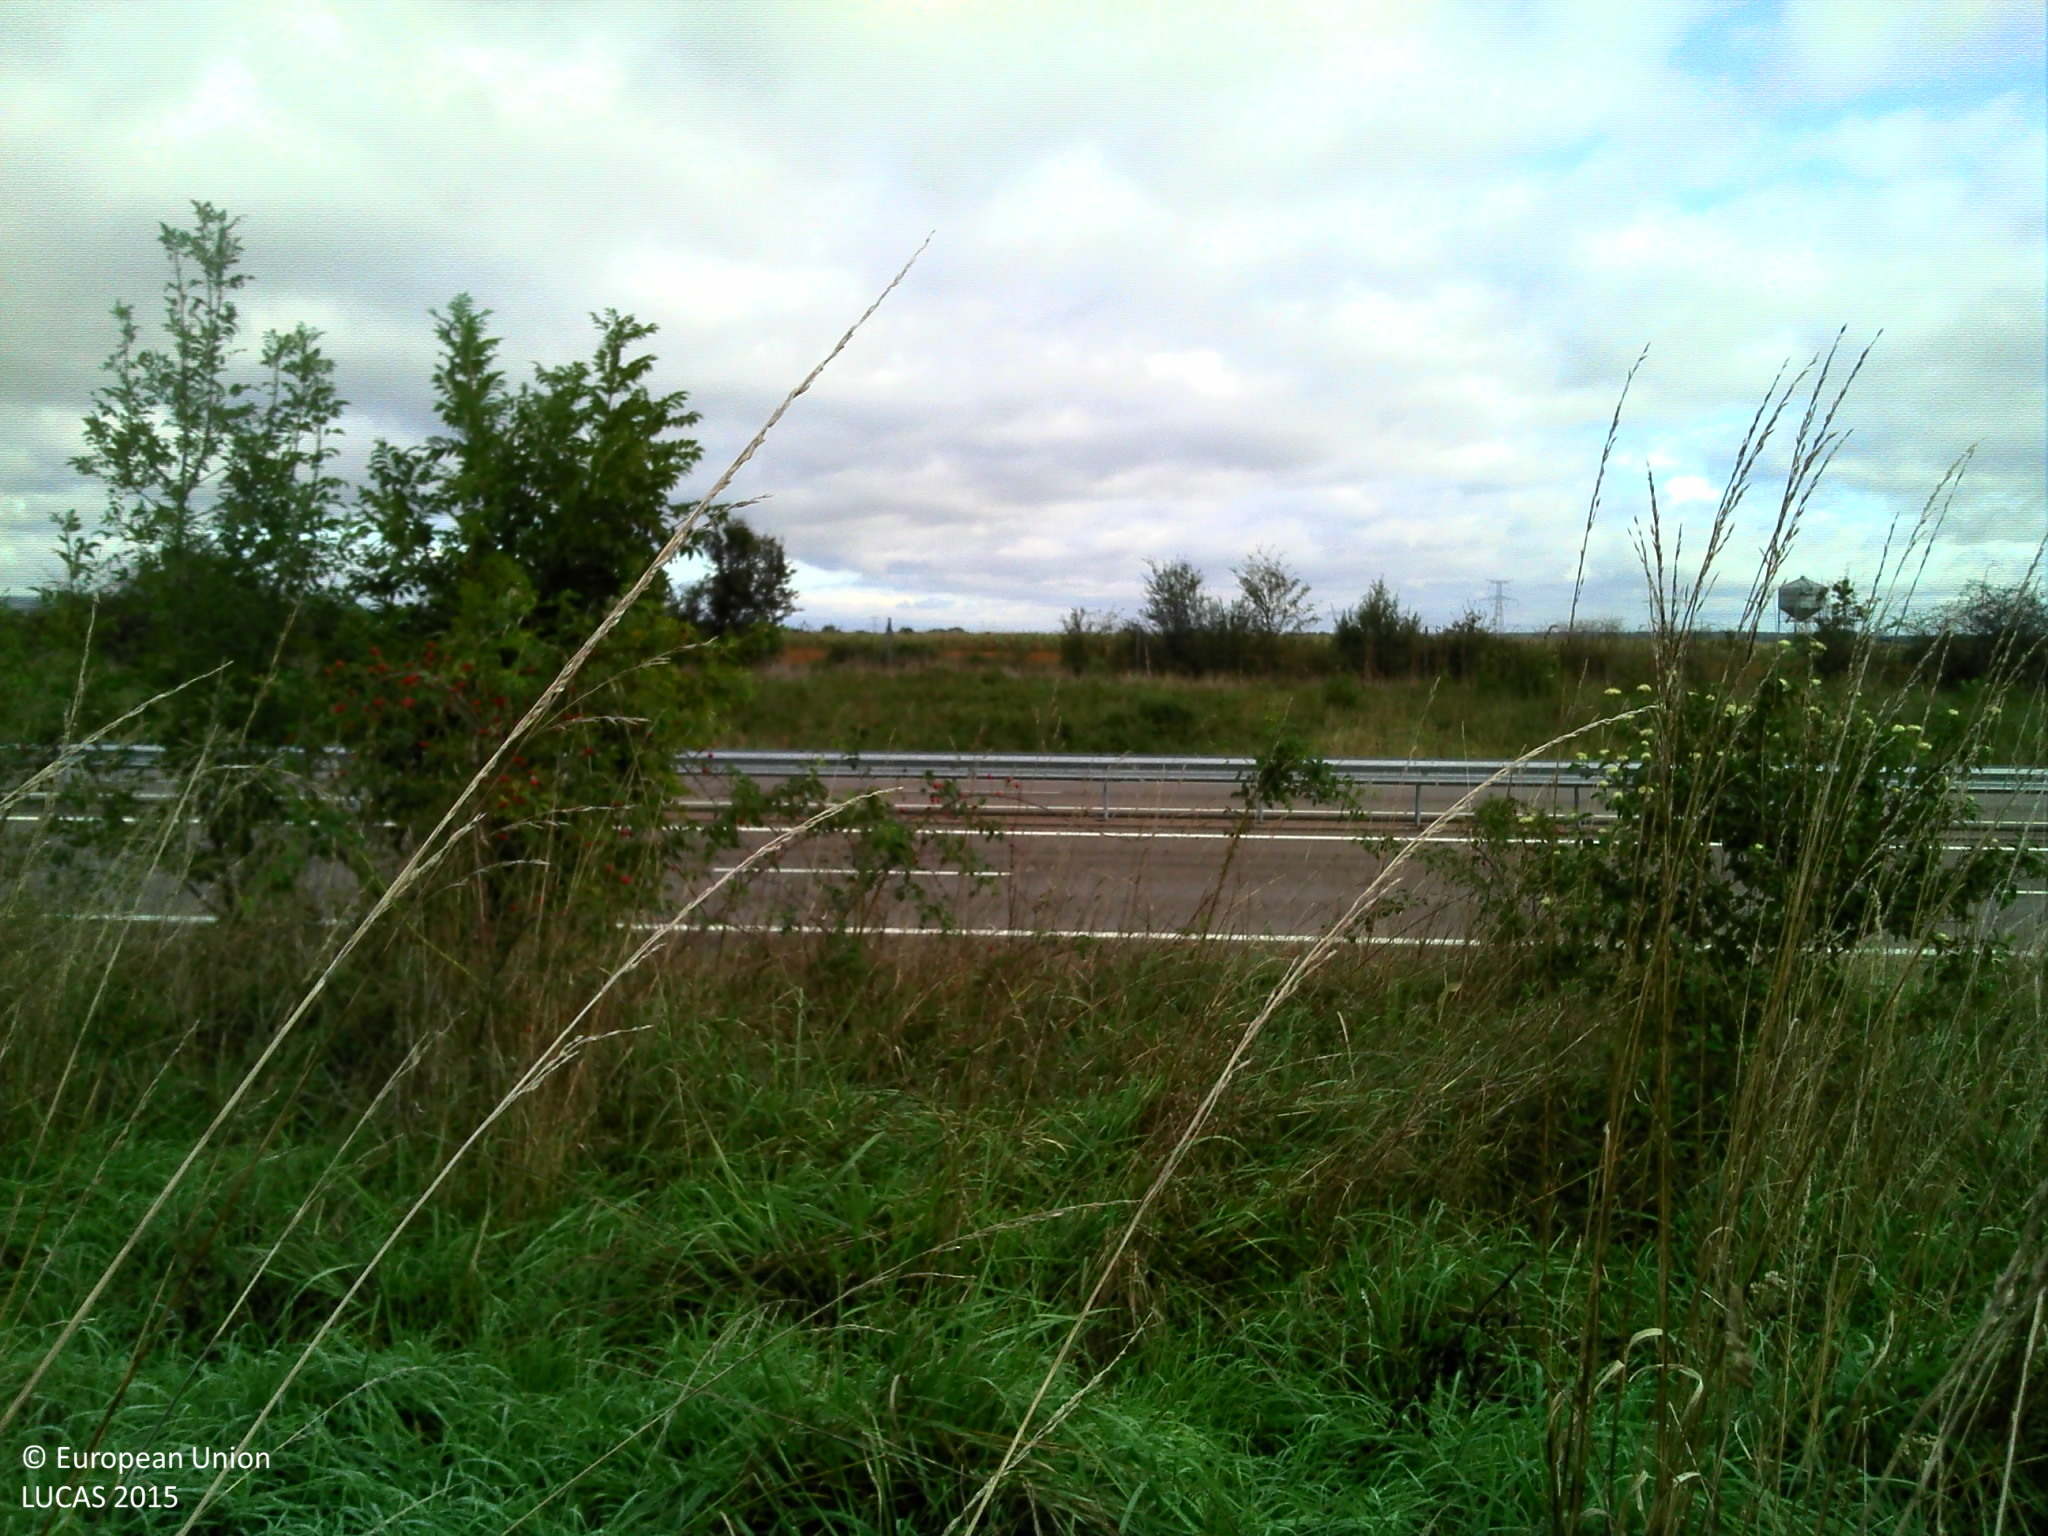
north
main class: Grassland
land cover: Grassland without tree/shrub cover
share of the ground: > 75 %
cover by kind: herbaceous plants 95 %, shrubs 5 %
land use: Road transport
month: September
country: FR
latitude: 47.0455
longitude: 4.9861
